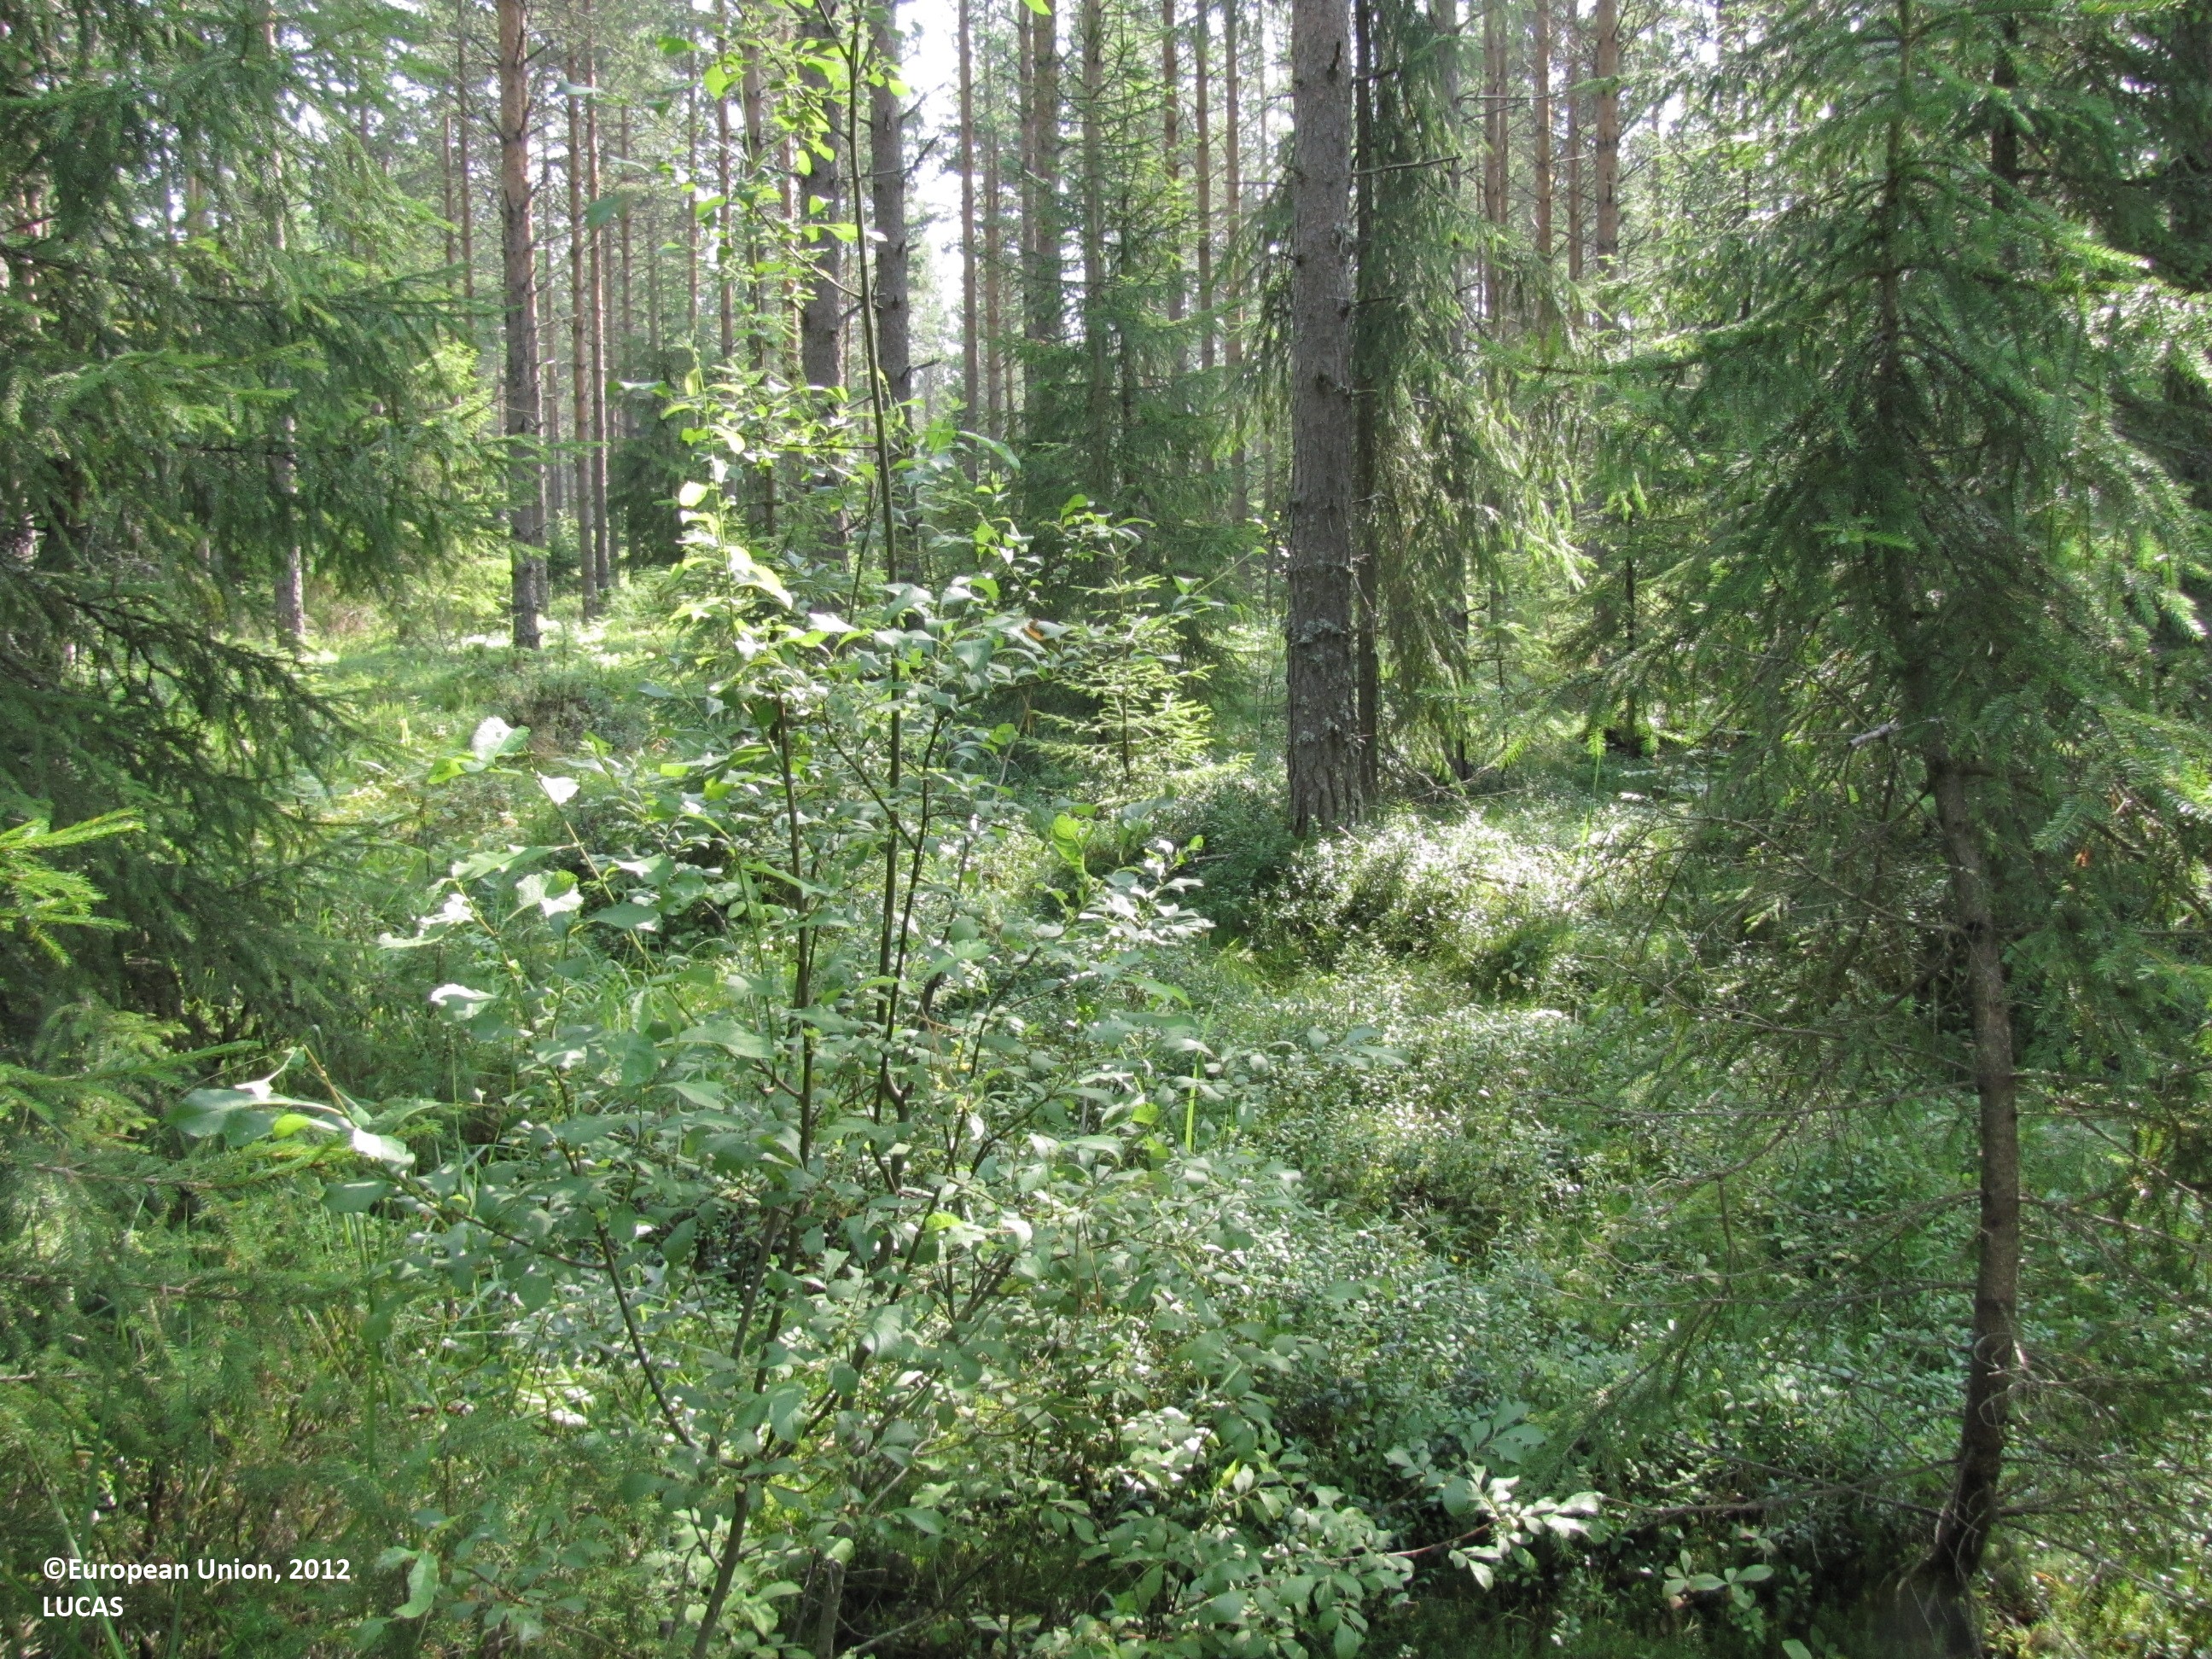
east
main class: Woodland
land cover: Other coniferous woodland
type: boreal forest
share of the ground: 50 - 75 %
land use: Forestry
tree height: > 5 m
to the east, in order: Other coniferous woodland; Pine dominated coniferous woodland; Ditches and canals; Grass margins; Tracks; Grass margins; Ditches and canals; Pine dominated coniferous woodland; Spruce dominated mixed woodland; Pine dominated coniferous woodland
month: July
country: FI
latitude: 62.0037
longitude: 23.2668
